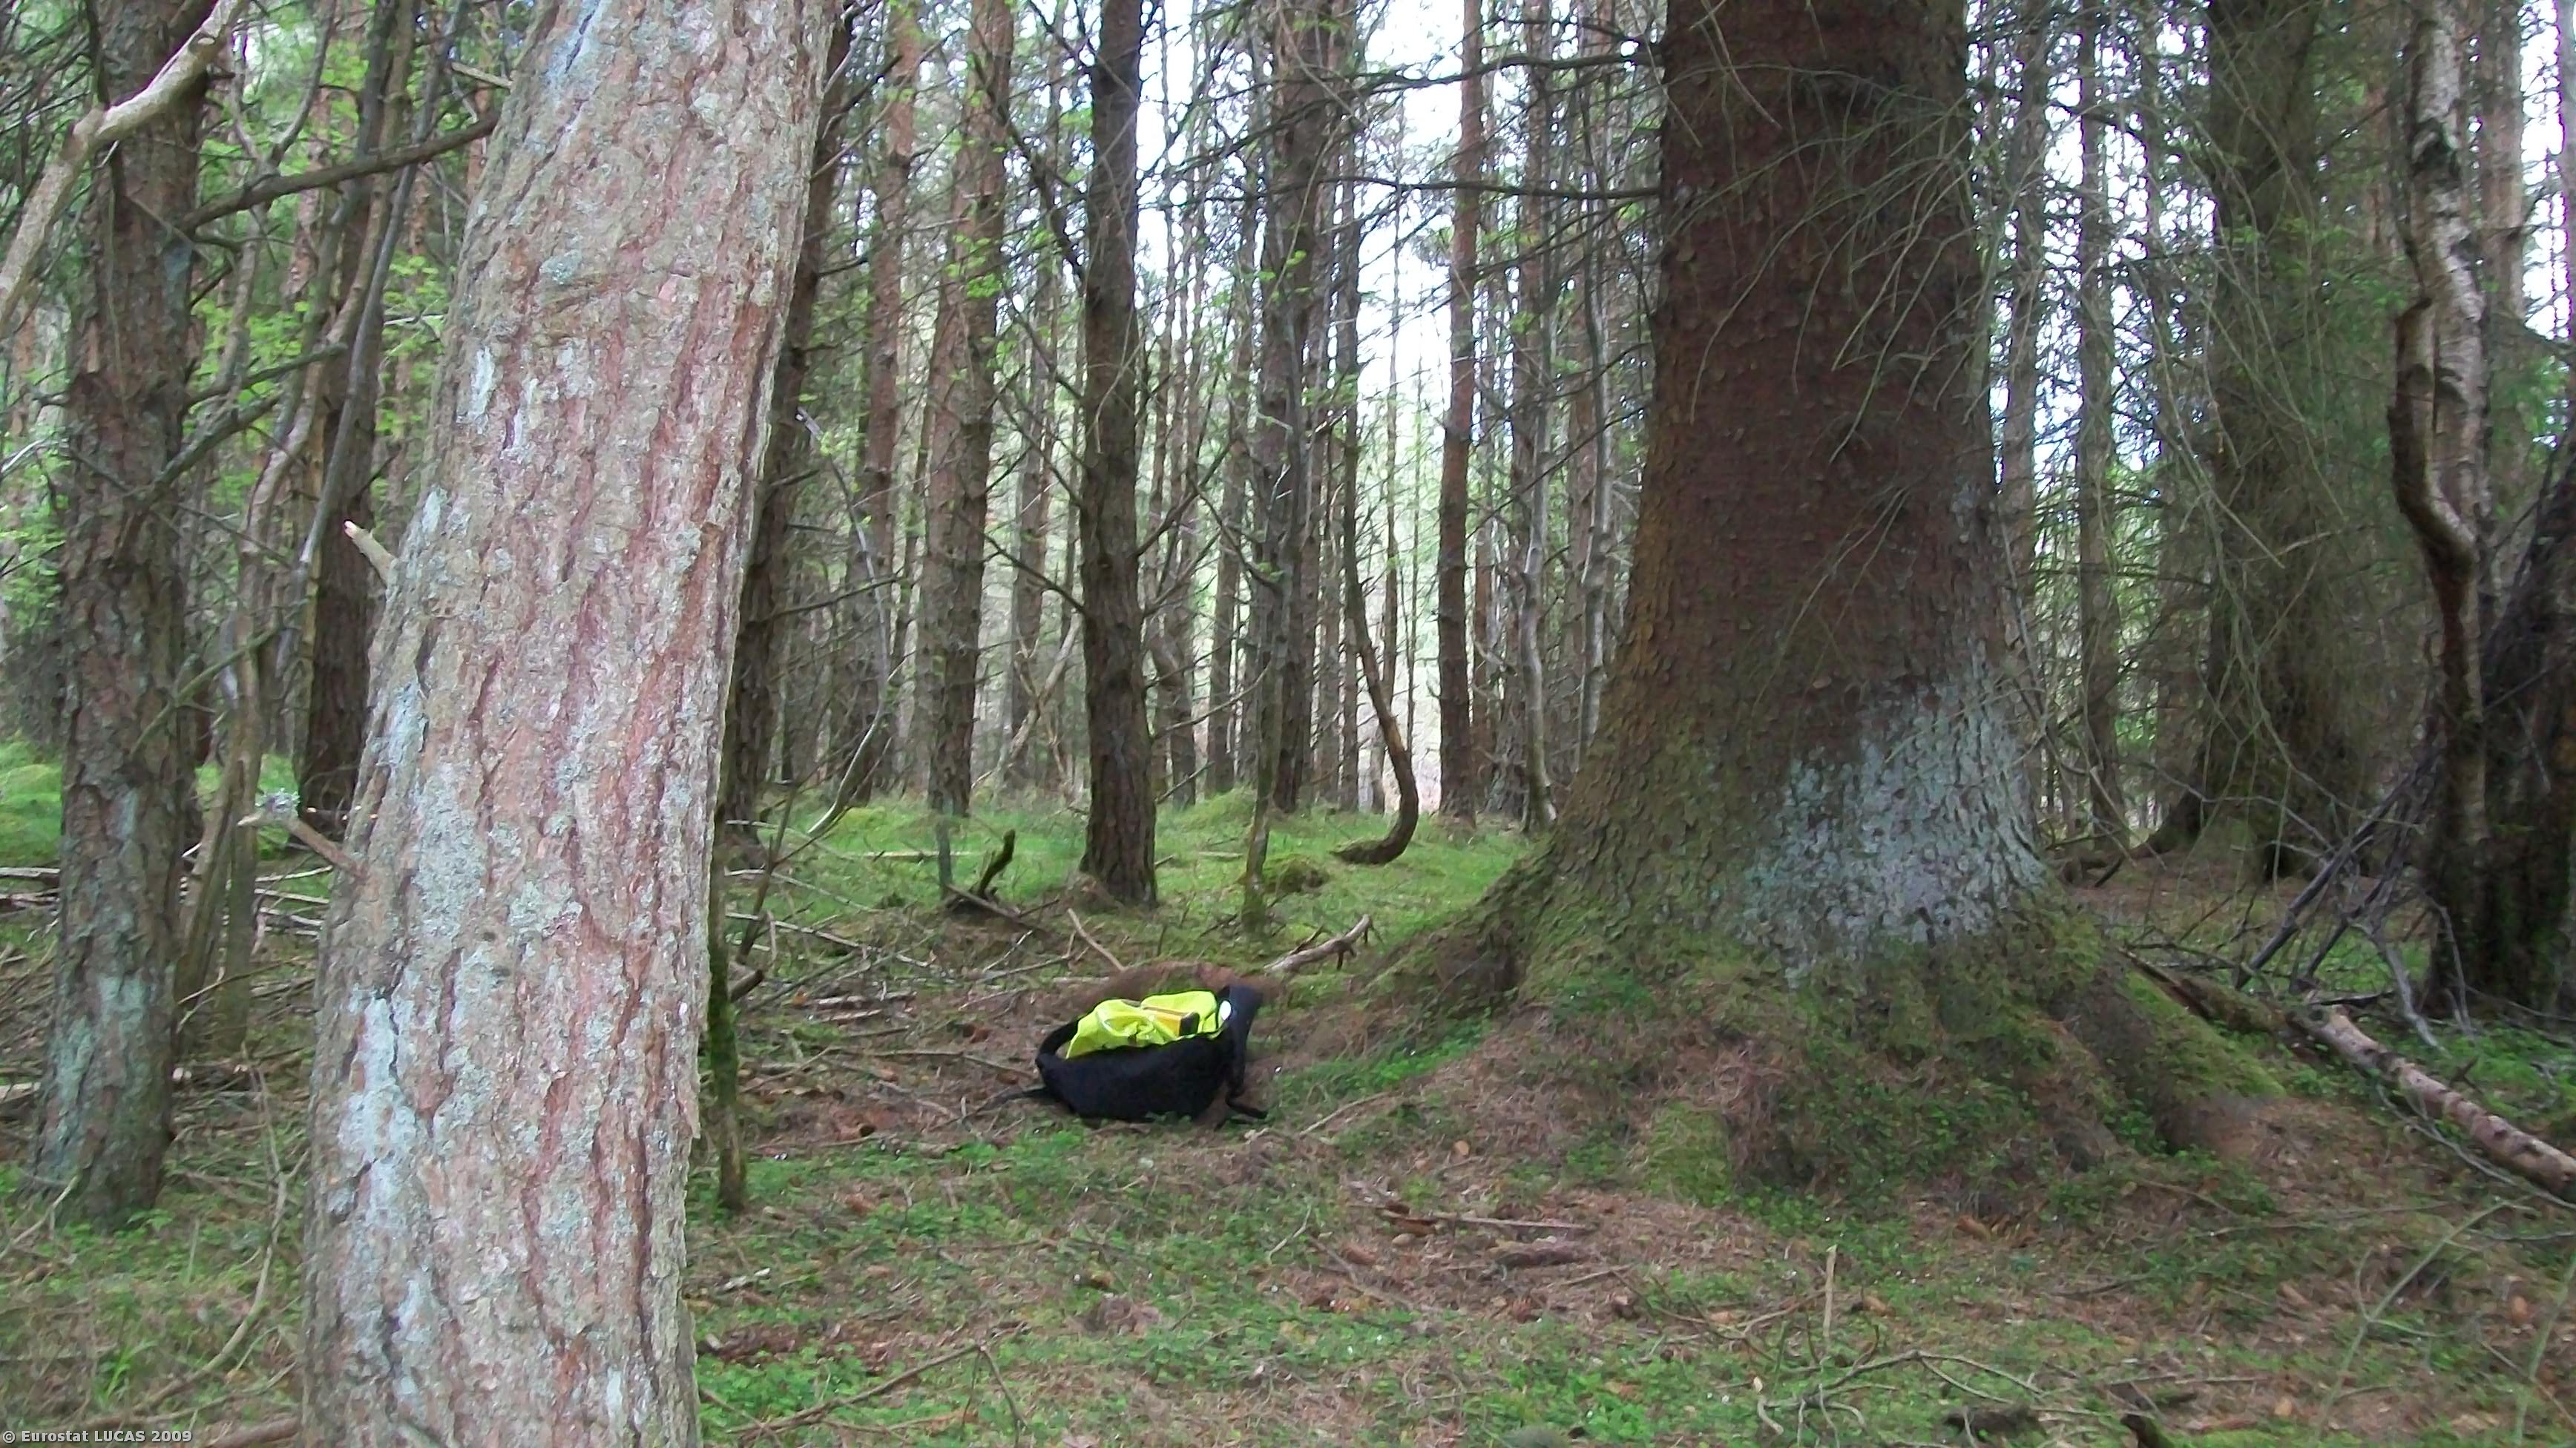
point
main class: Woodland
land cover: Mixed woodland
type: mesophytic deciduous forest
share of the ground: > 75 %
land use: Forestry
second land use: Amenities, museums, leisure
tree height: > 5 m
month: June
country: GB
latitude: 57.6514
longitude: -2.8771
